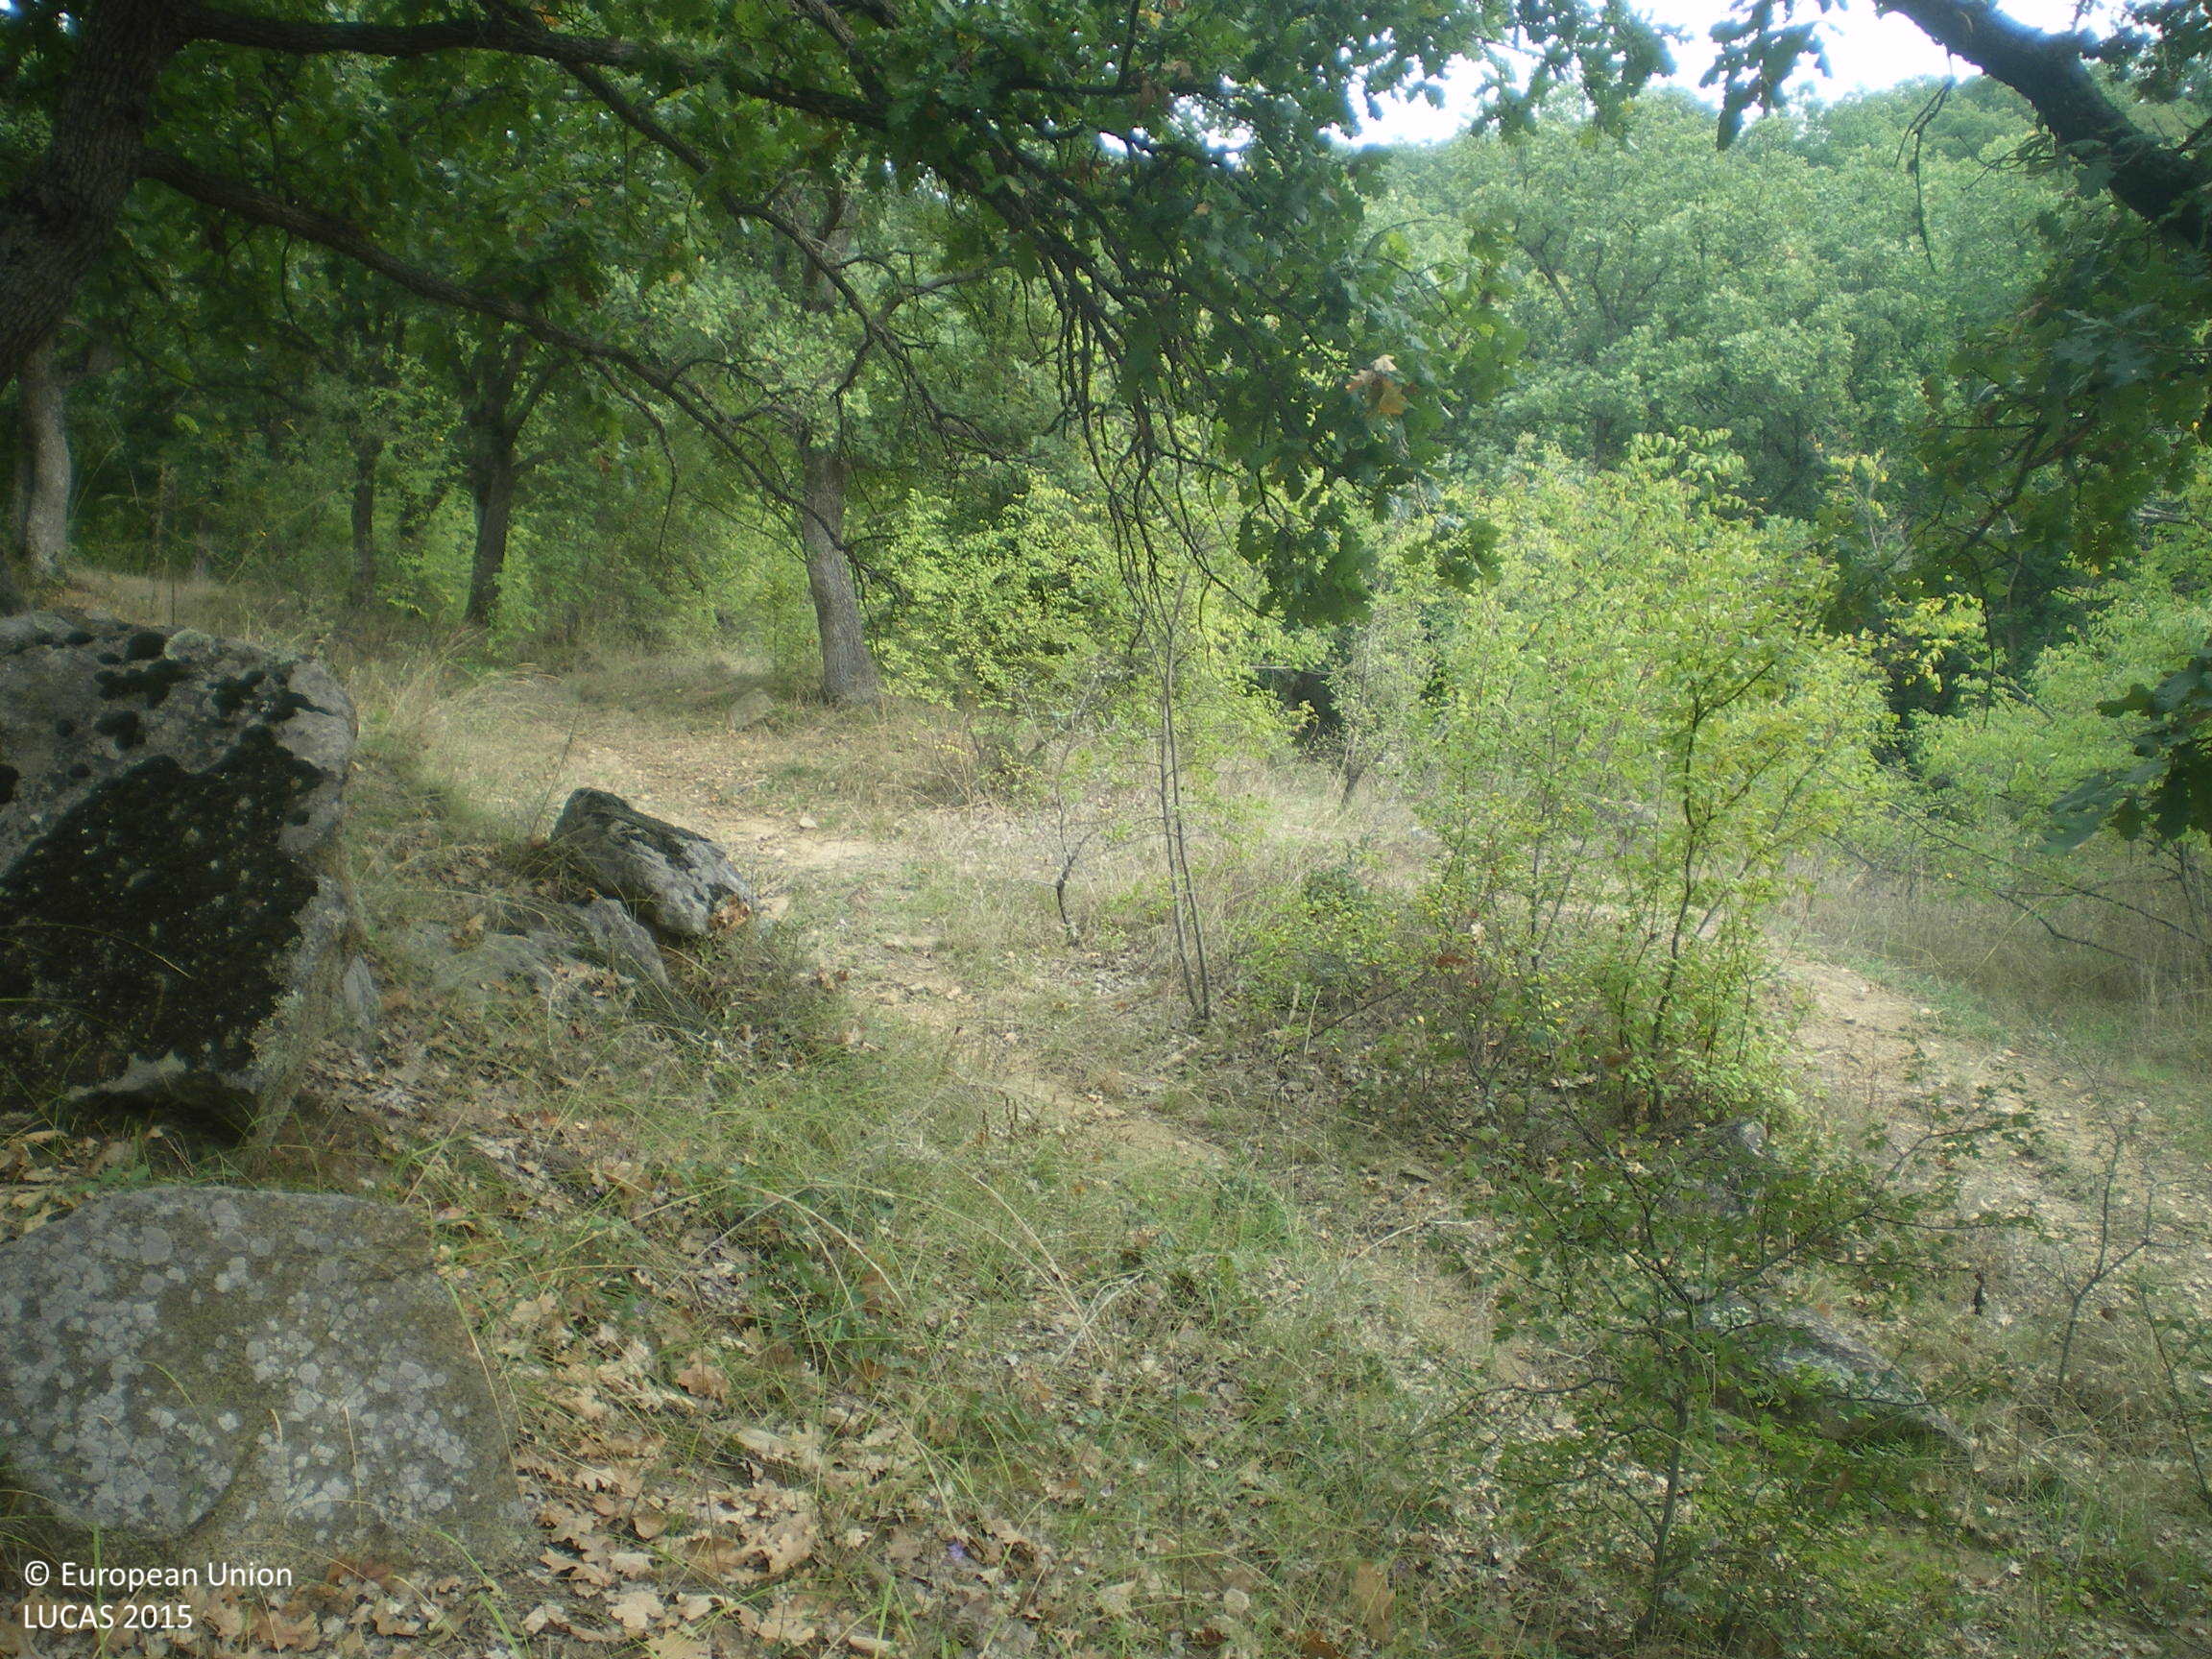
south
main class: Woodland
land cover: Broadleaved woodland
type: mesophytic deciduous forest
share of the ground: > 75 %
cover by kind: broadleaved forest trees 60 %, unconsolidated bare surface 20 %, shrubs 10 %, herbaceous plants 10 %
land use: Forestry
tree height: > 5 m
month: September
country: BG
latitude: 41.8681
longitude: 25.8893
